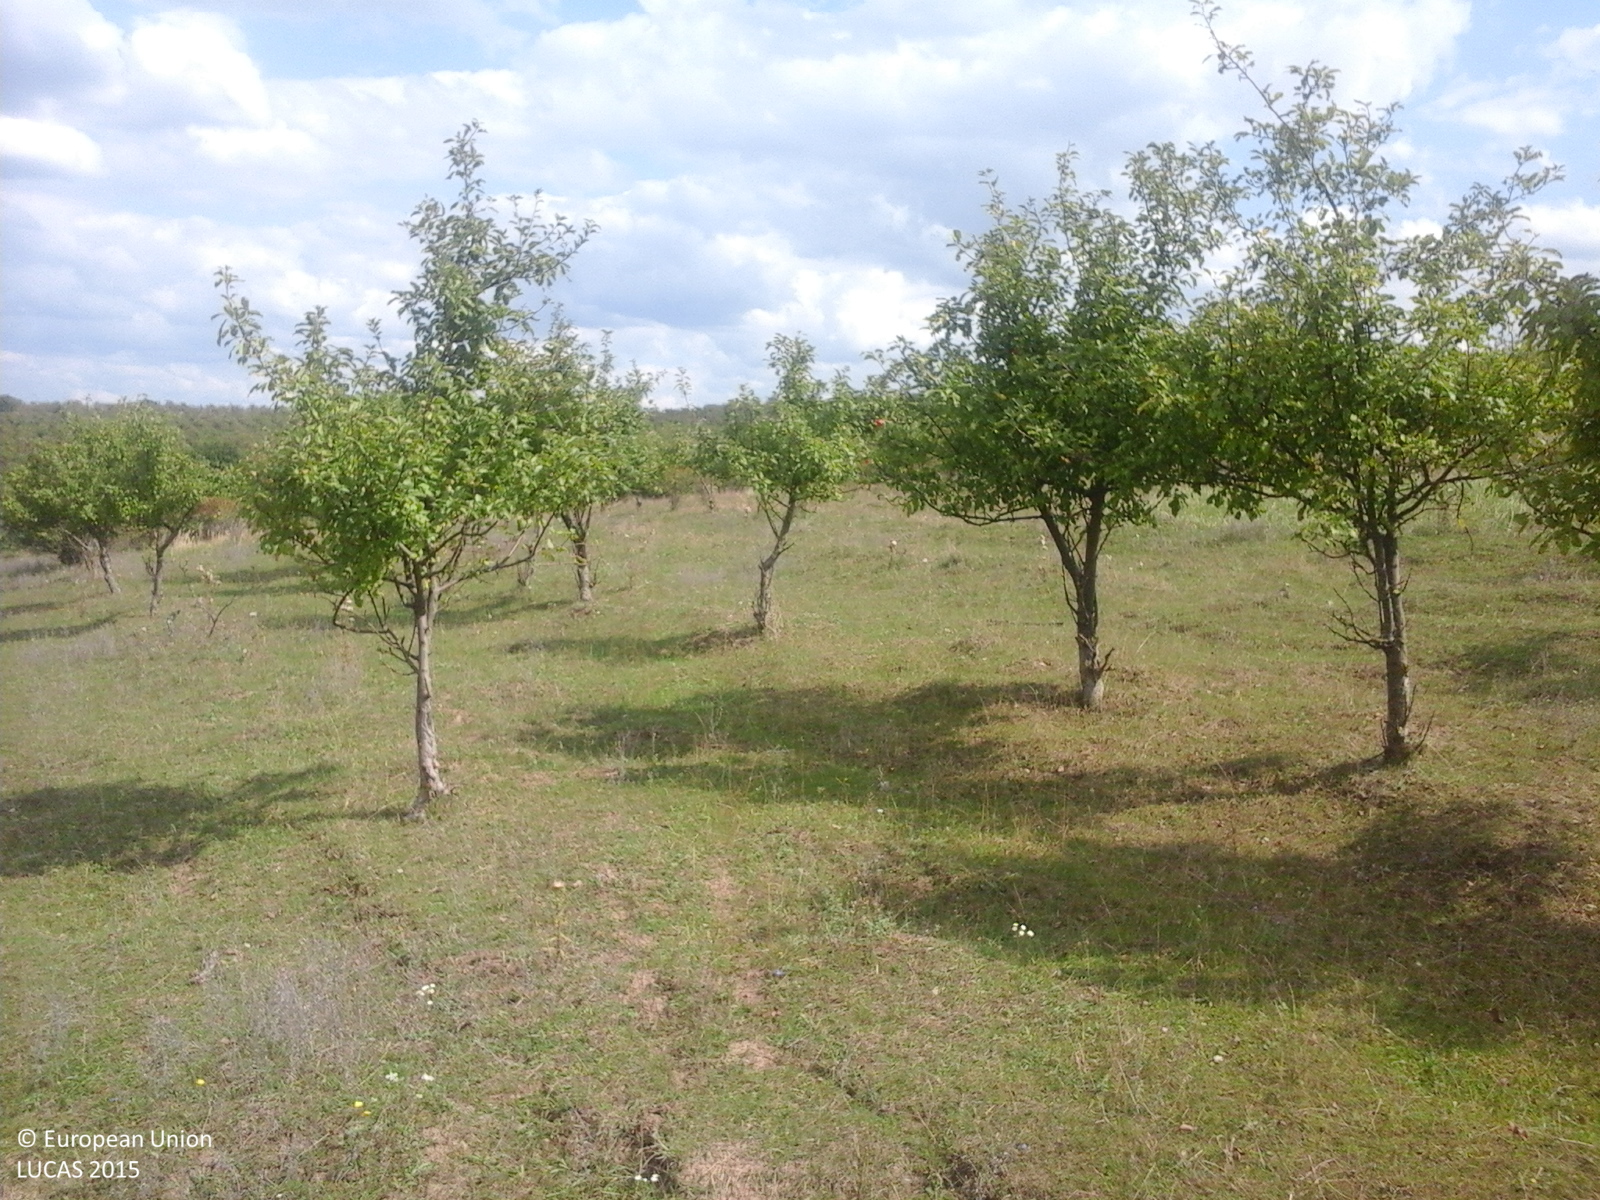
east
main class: Cropland
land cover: Apple fruit
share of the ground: > 75 %
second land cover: Grassland without tree/shrub cover
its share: > 75 %
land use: Agriculture (excluding fallow land and kitchen gardens)
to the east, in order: Apple fruit; Grassland without tree/shrub cover; Other fruit trees and berries; Ditches and canals; Other fruit trees and berries
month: September
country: RO
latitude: 47.2859
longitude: 22.8467
